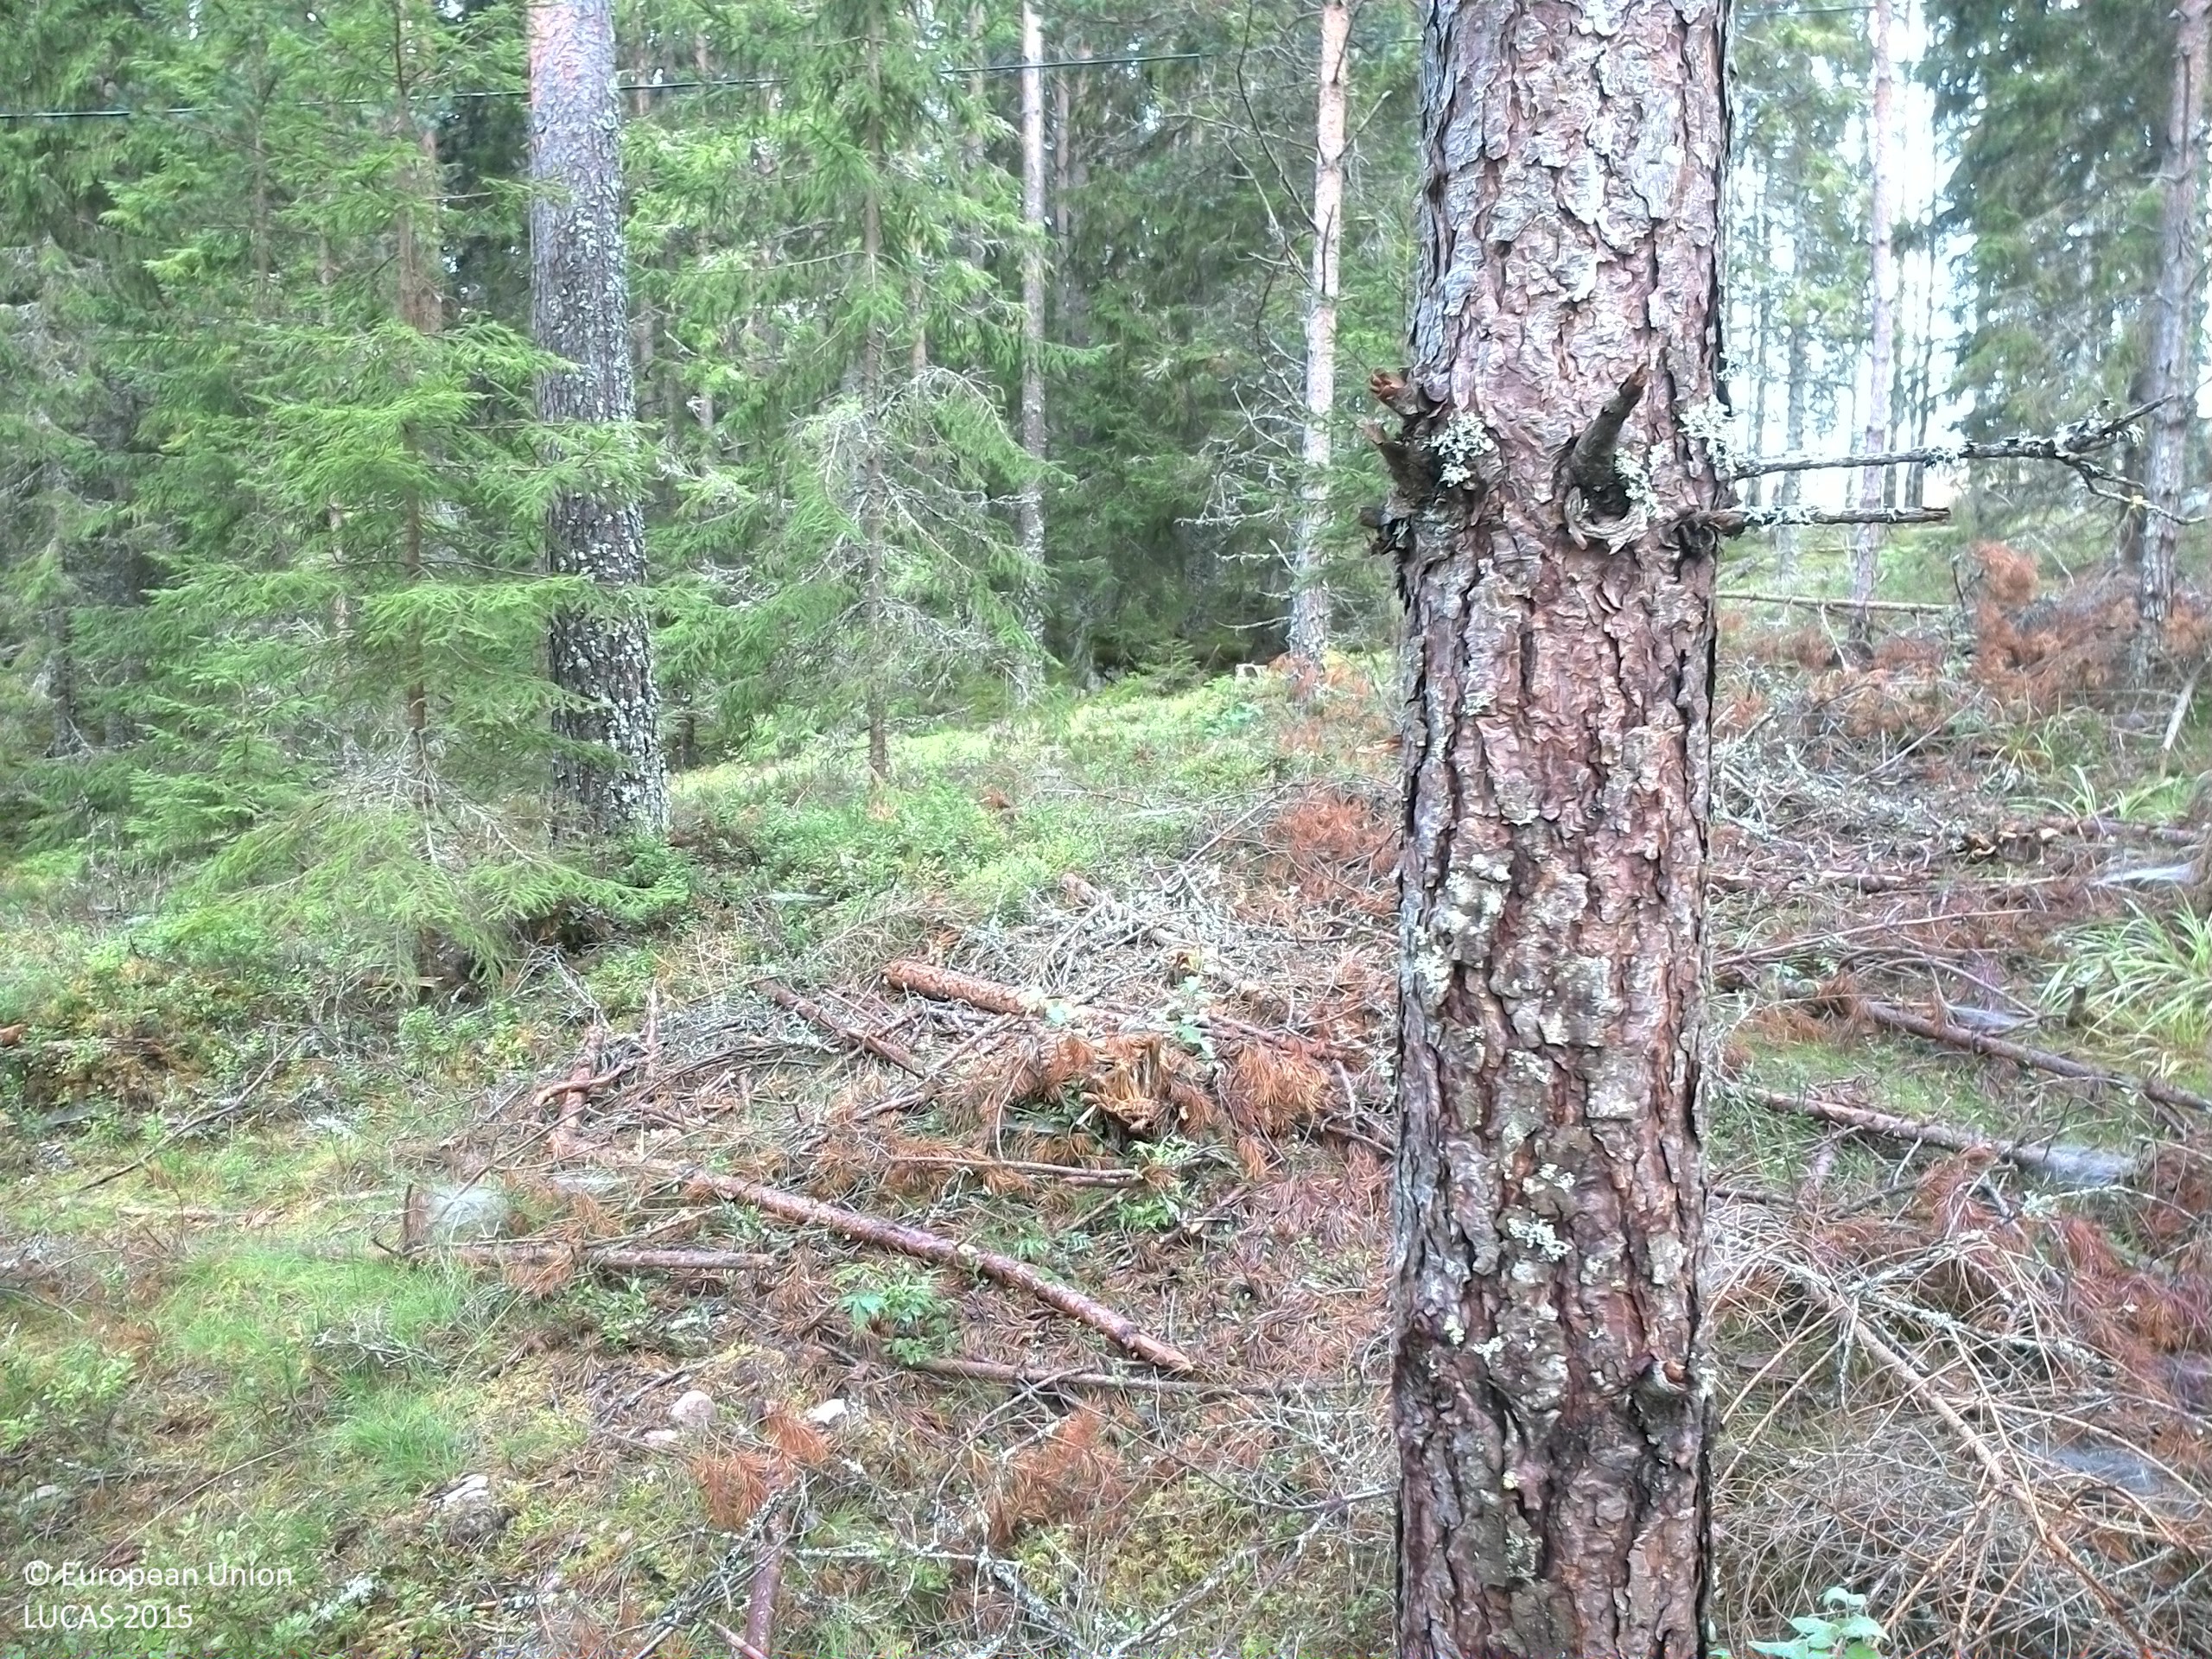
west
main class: Woodland
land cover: Pine dominated coniferous woodland
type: boreal forest
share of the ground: 50 - 75 %
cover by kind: coniferous forest trees 60 %, shrubs 20 %, lichens and mosses 15 %, herbaceous plants 5 %
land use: Forestry
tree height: > 5 m
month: September
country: SE
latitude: 59.8180
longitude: 13.2905
